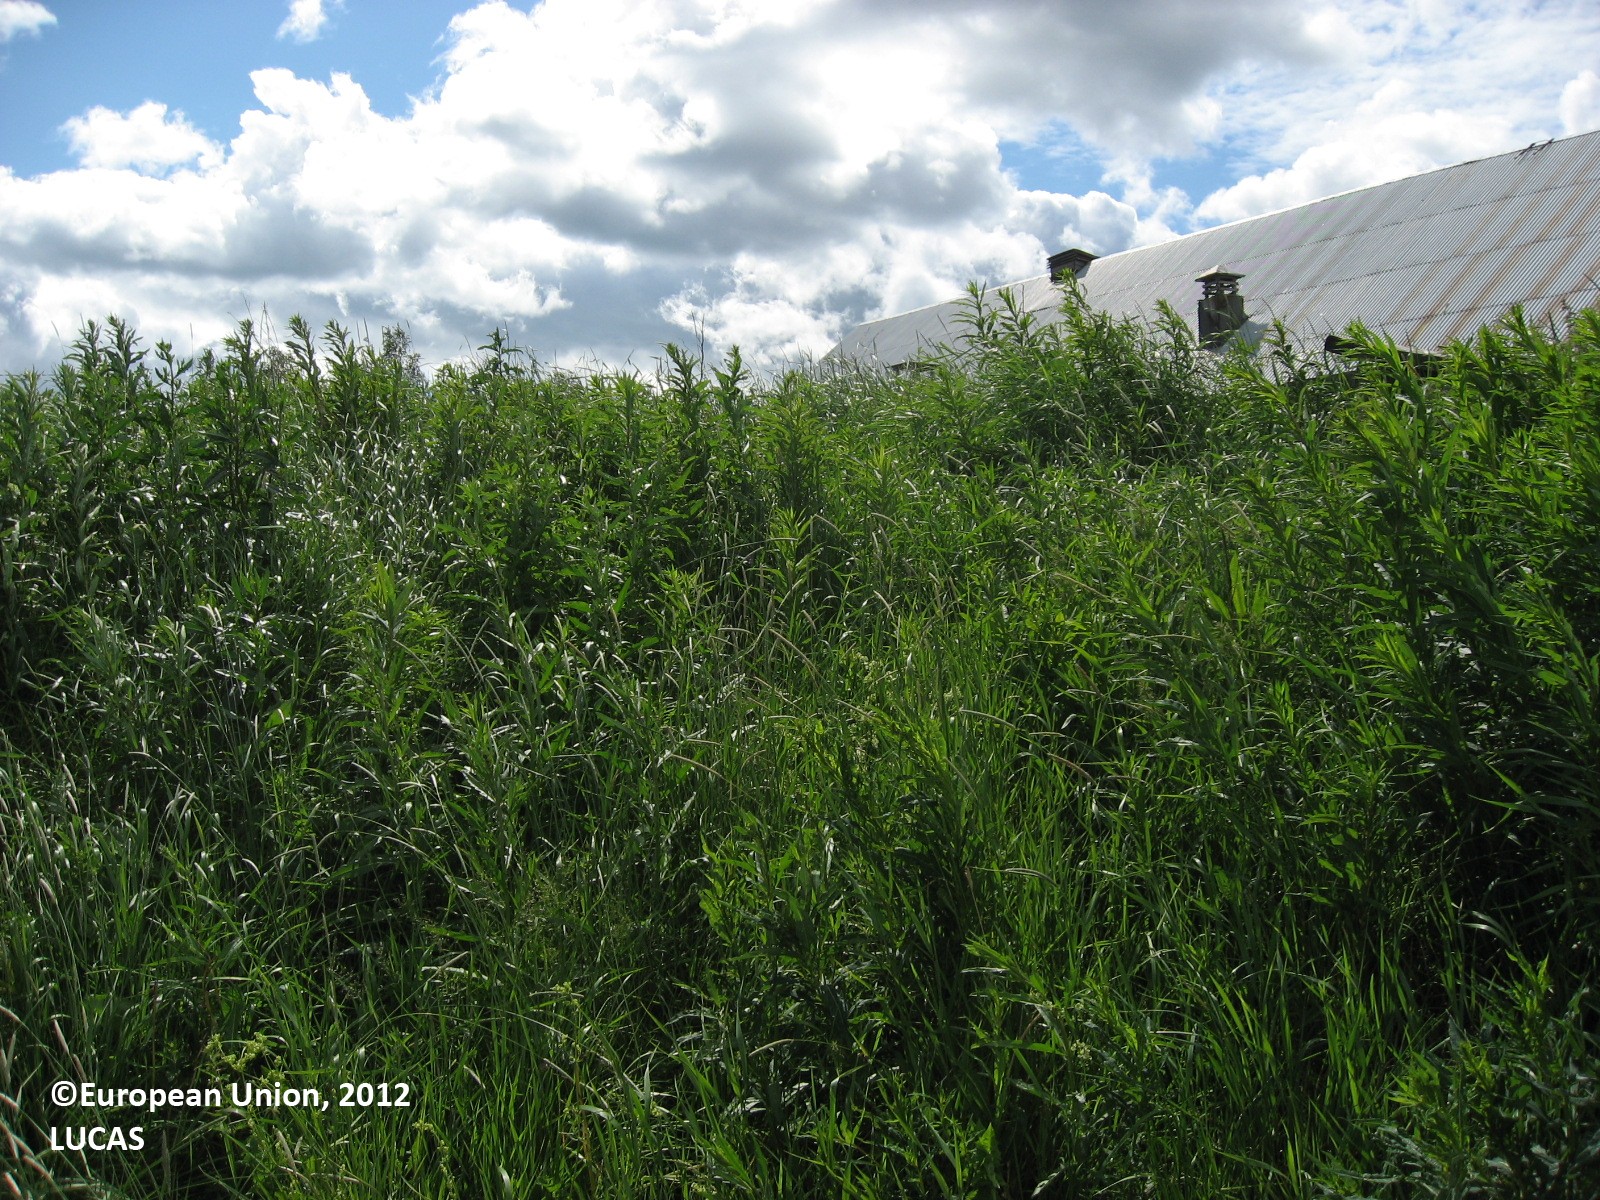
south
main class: Cropland
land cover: Oats
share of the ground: 50 - 75 %
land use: Agriculture (excluding fallow land and kitchen gardens)
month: June
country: FI
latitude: 60.7275
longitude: 26.5273
